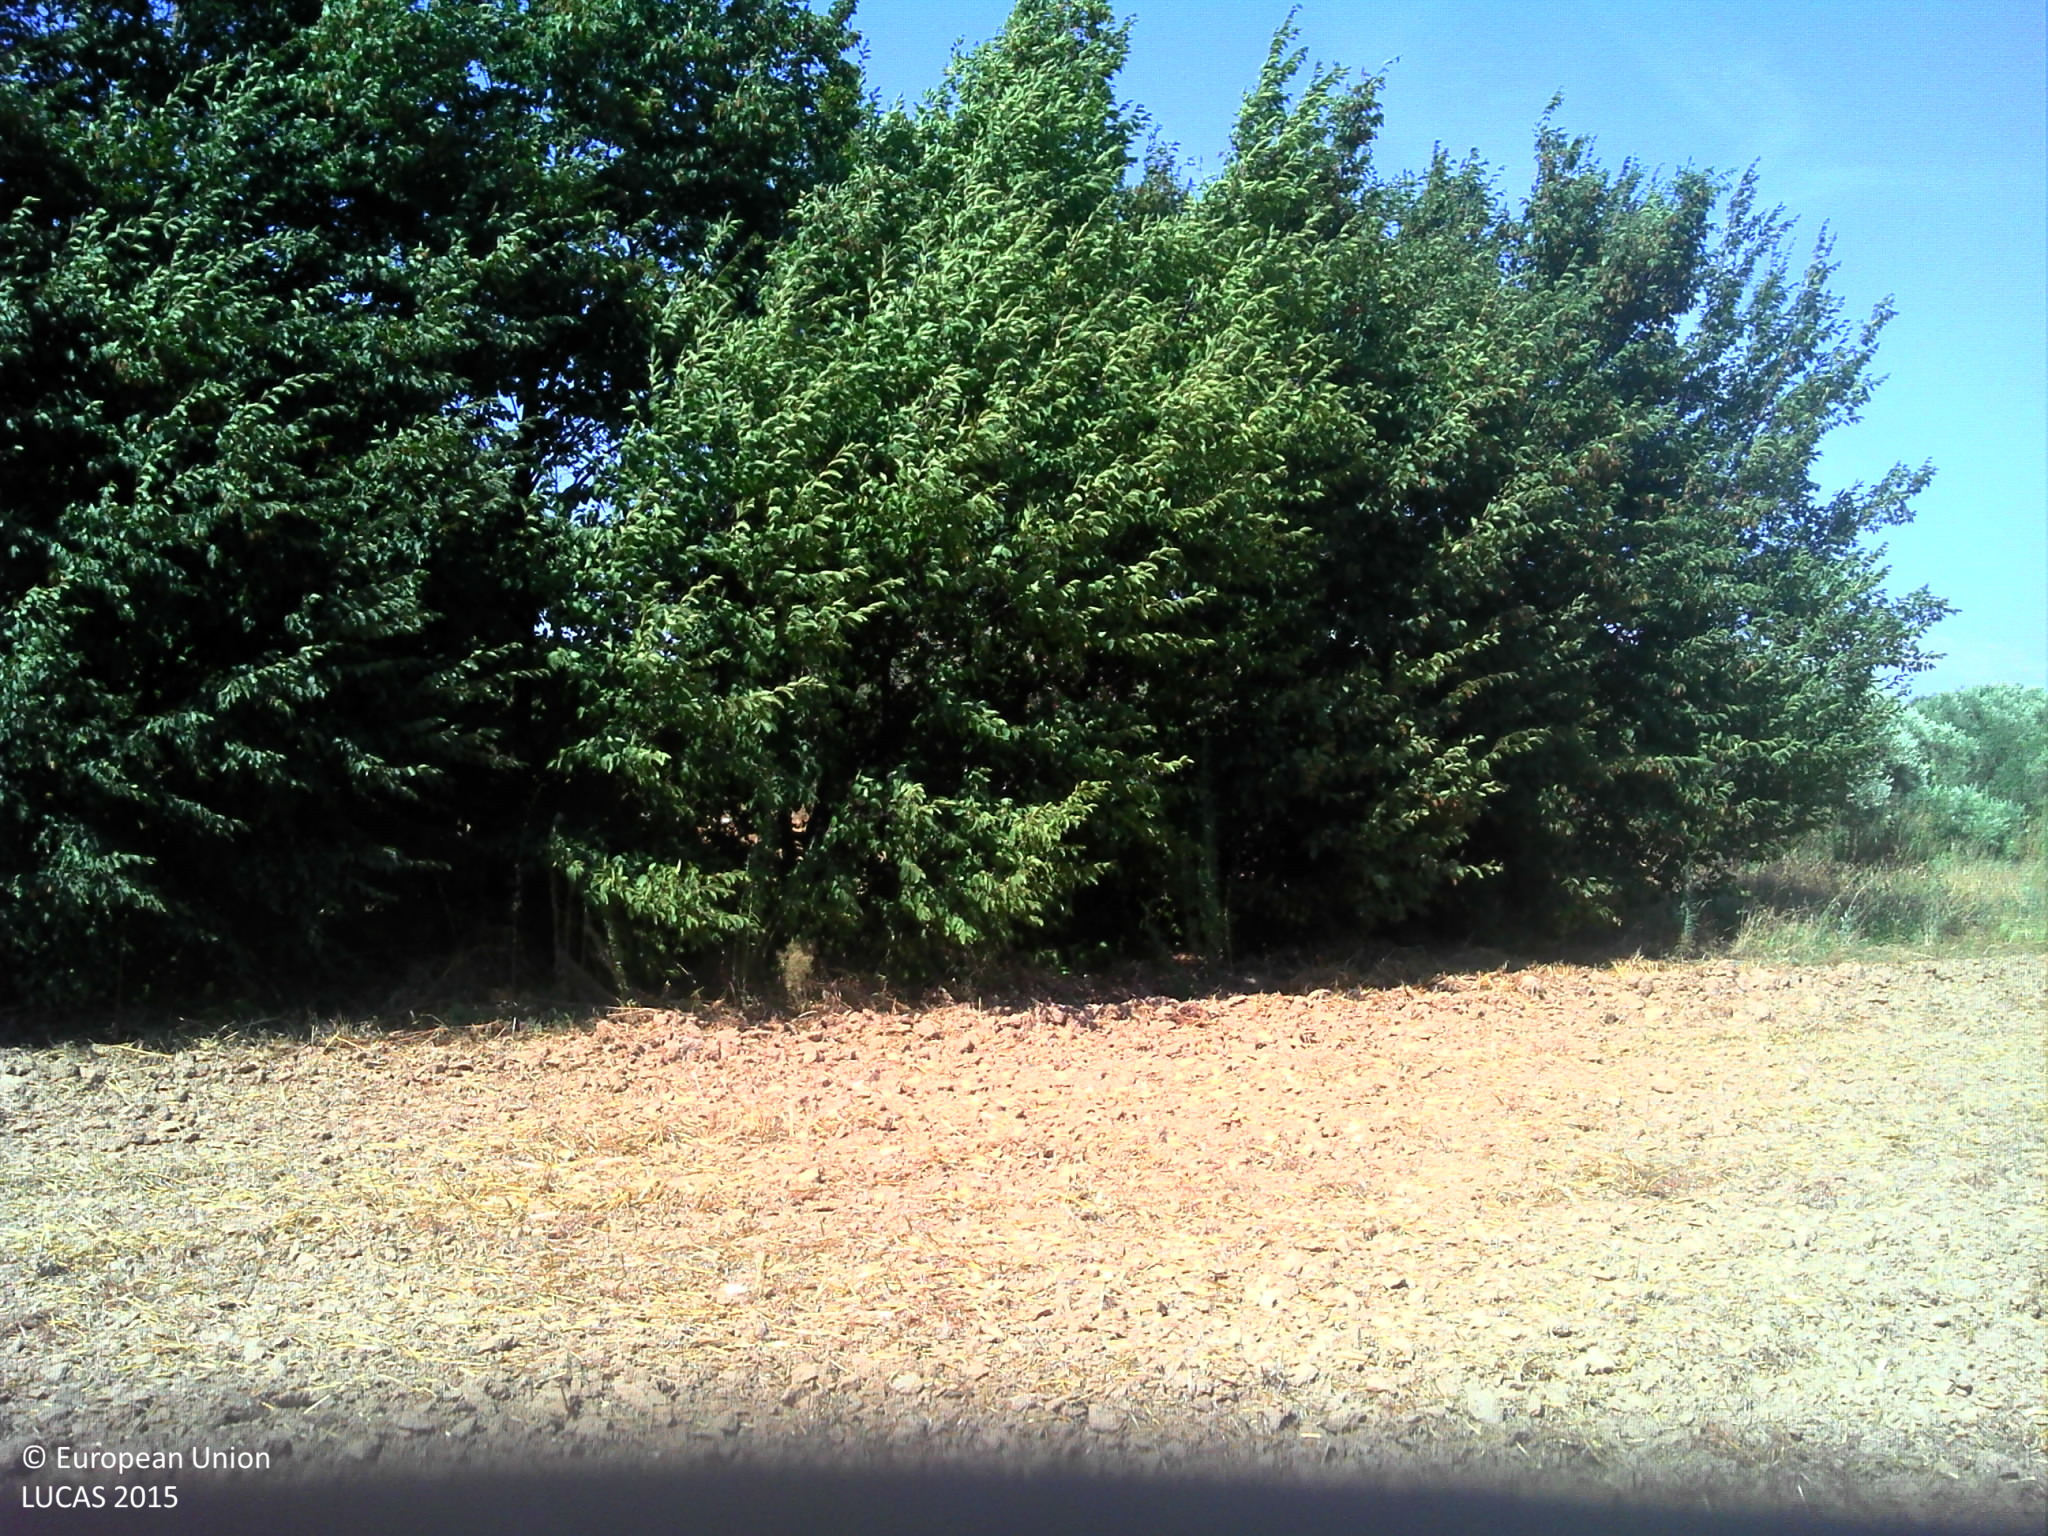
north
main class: Cropland
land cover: Durum wheat
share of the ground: < 10 %
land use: Agriculture (excluding fallow land and kitchen gardens)
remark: Harvested field
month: August
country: FR
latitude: 43.4963
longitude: 5.1498
